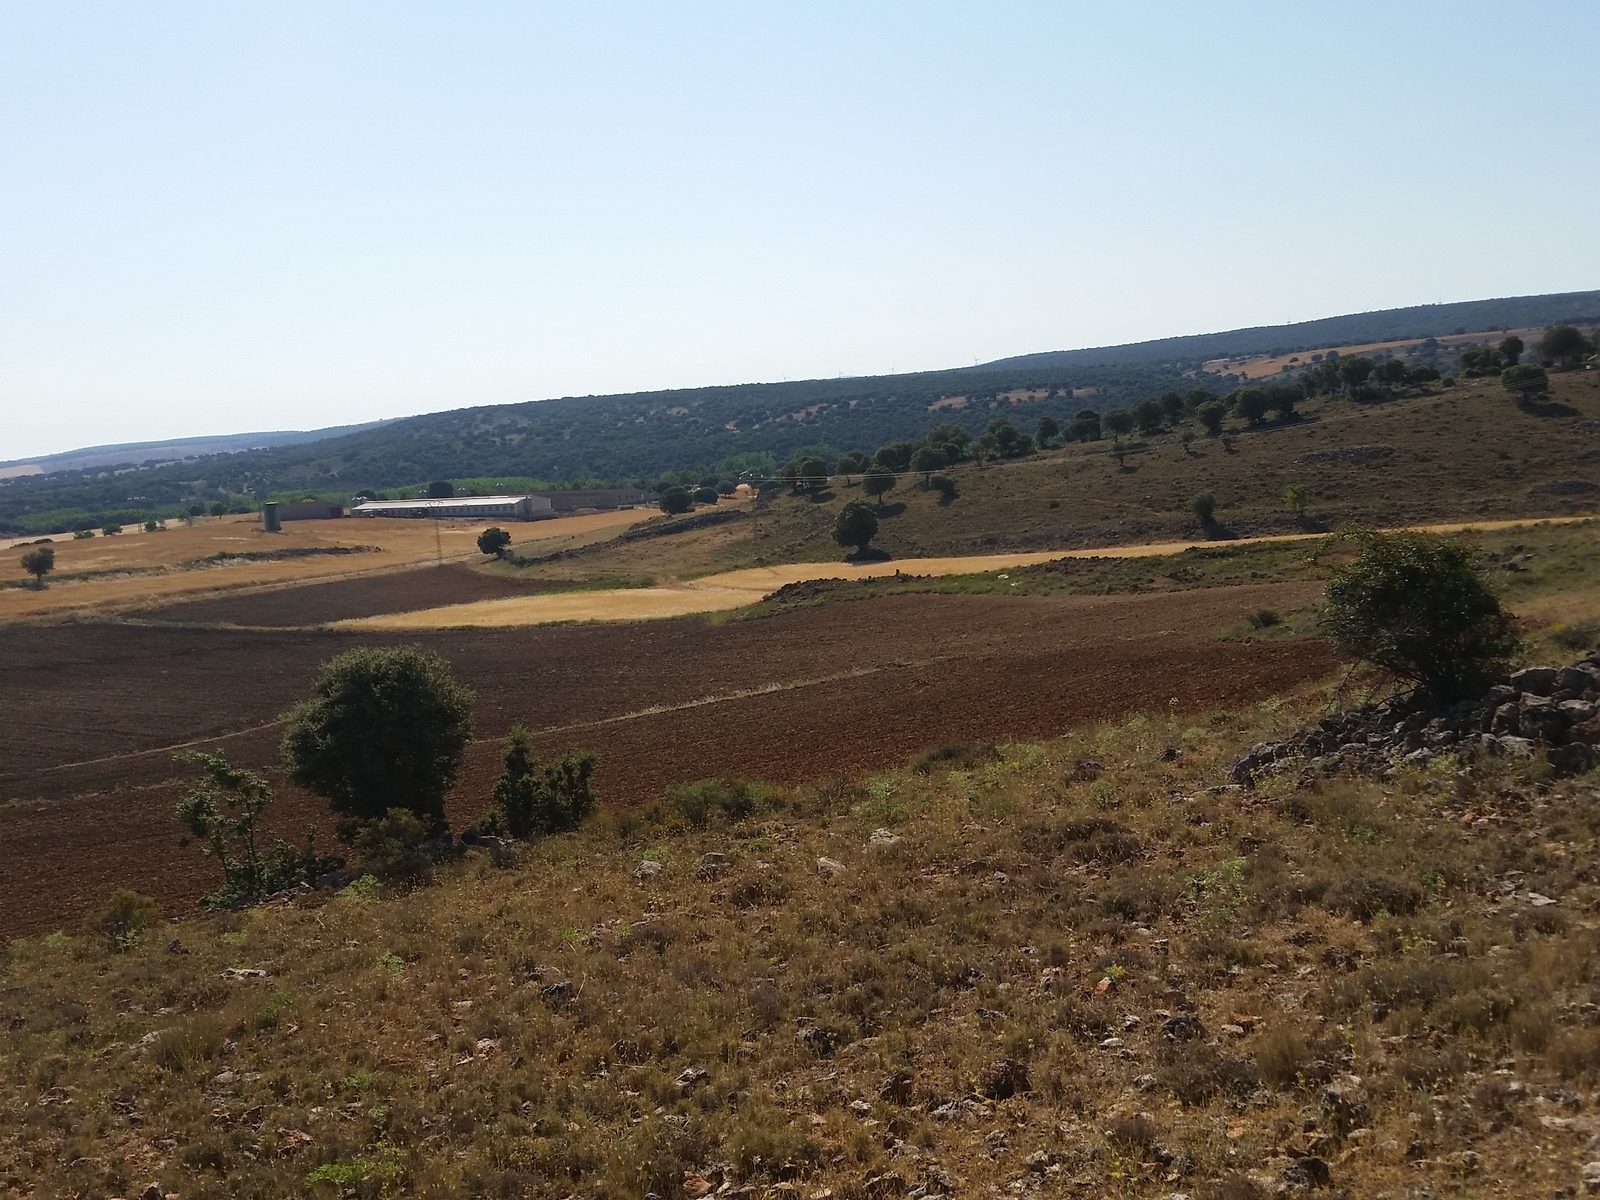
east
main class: Shrubland
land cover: Shrubland without tree cover
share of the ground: > 75 %
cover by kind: shrubs 60 %, consolidated bare surface 25 %, herbaceous plants 15 %
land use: Semi-natural and natural areas not in use
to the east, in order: Shrubland without tree cover; Other bare soil; Dry stone walls; Other bare soil; Grass margins; Other bare soil; Grass margins; Common wheat
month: June
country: ES
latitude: 38.7586
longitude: -2.4418
